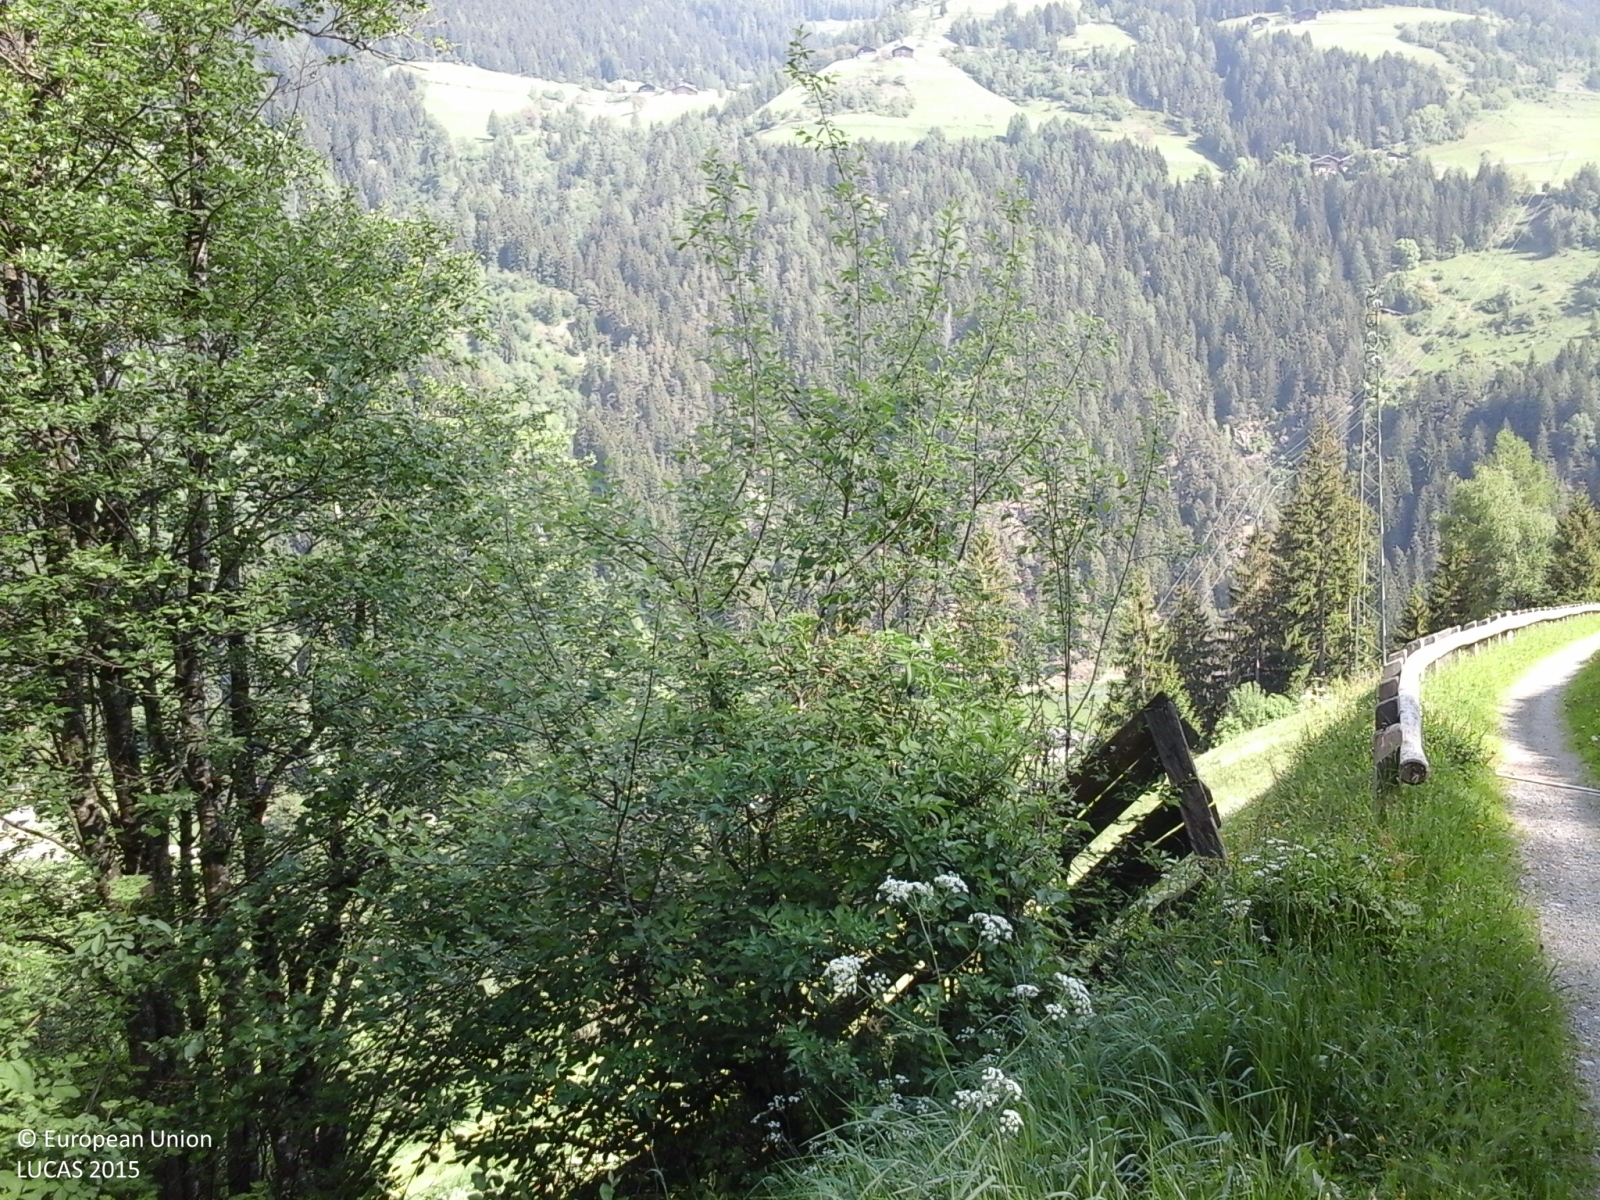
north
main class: Woodland
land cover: Spruce dominated mixed woodland
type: alpine coniferous forest
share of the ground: > 75 %
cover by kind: coniferous forest trees 70 %, broadleaved forest trees 30 %
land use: Forestry
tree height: > 5 m
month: May
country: IT
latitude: 46.5622
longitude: 11.0554
